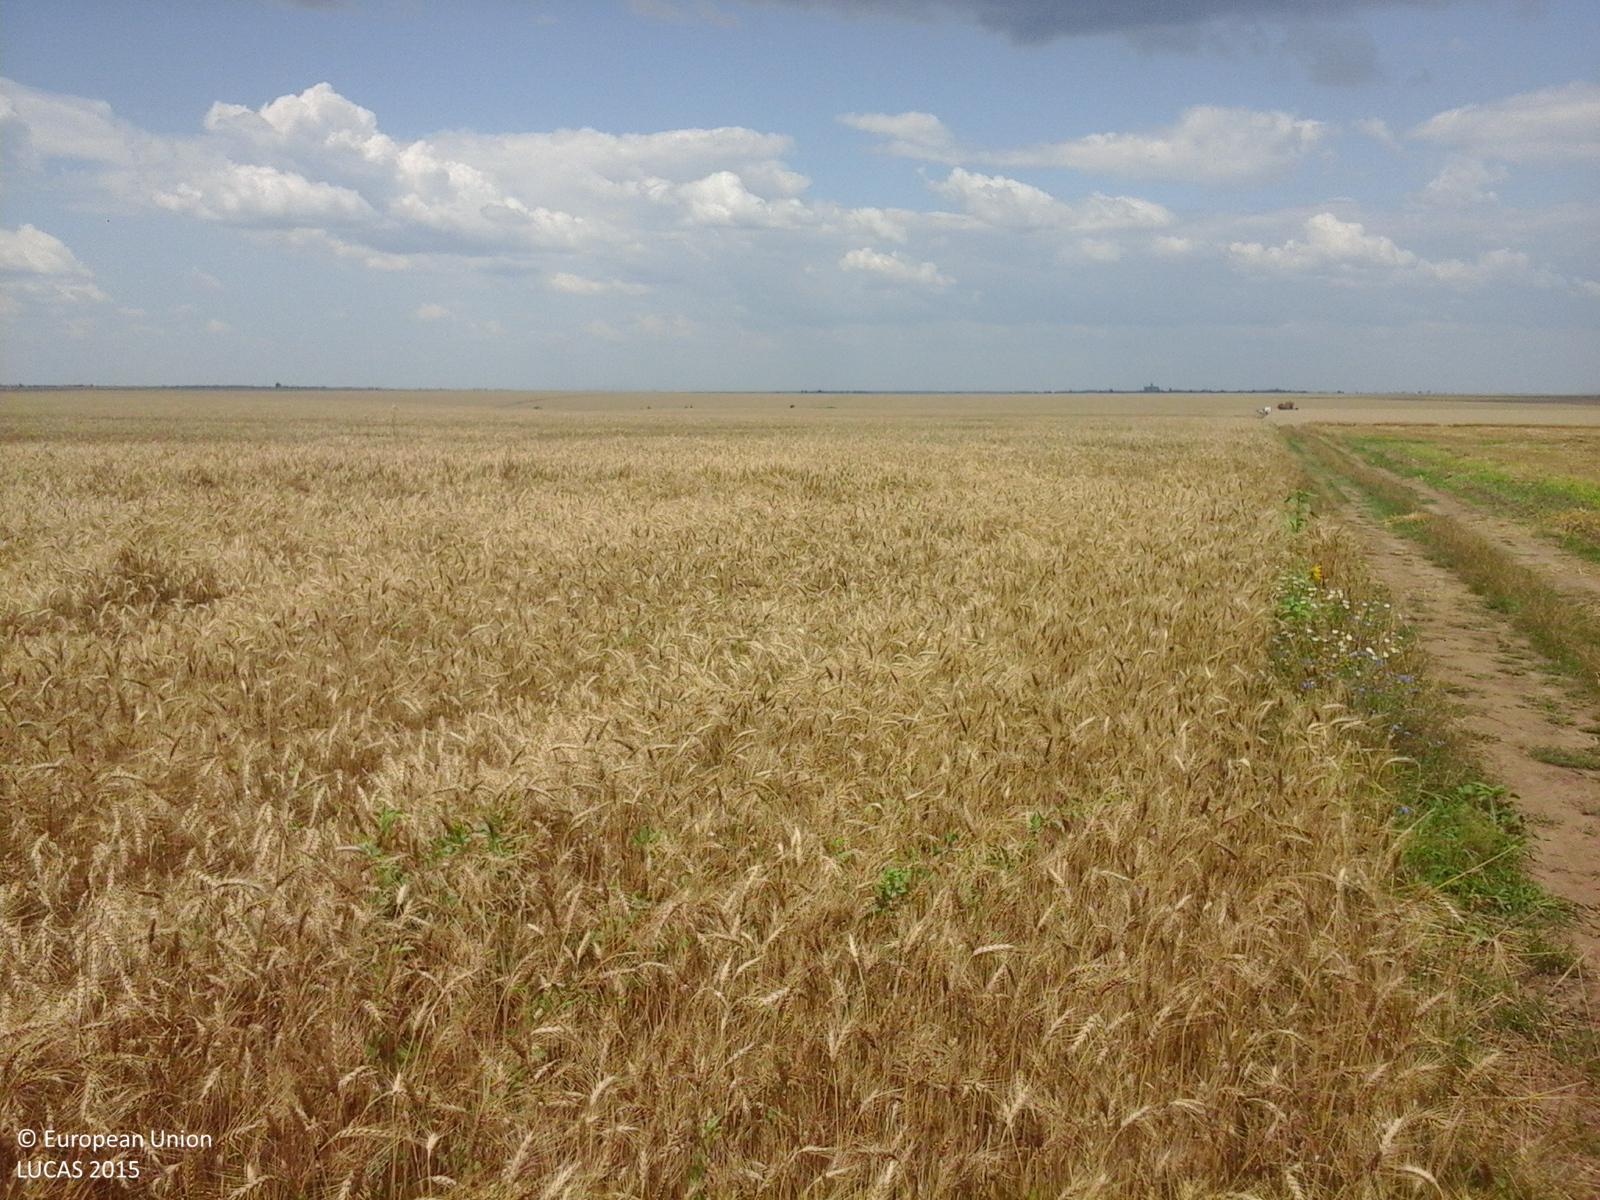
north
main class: Cropland
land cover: Common wheat
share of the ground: > 75 %
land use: Agriculture (excluding fallow land and kitchen gardens)
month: July
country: RO
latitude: 44.0284
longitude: 24.7060
